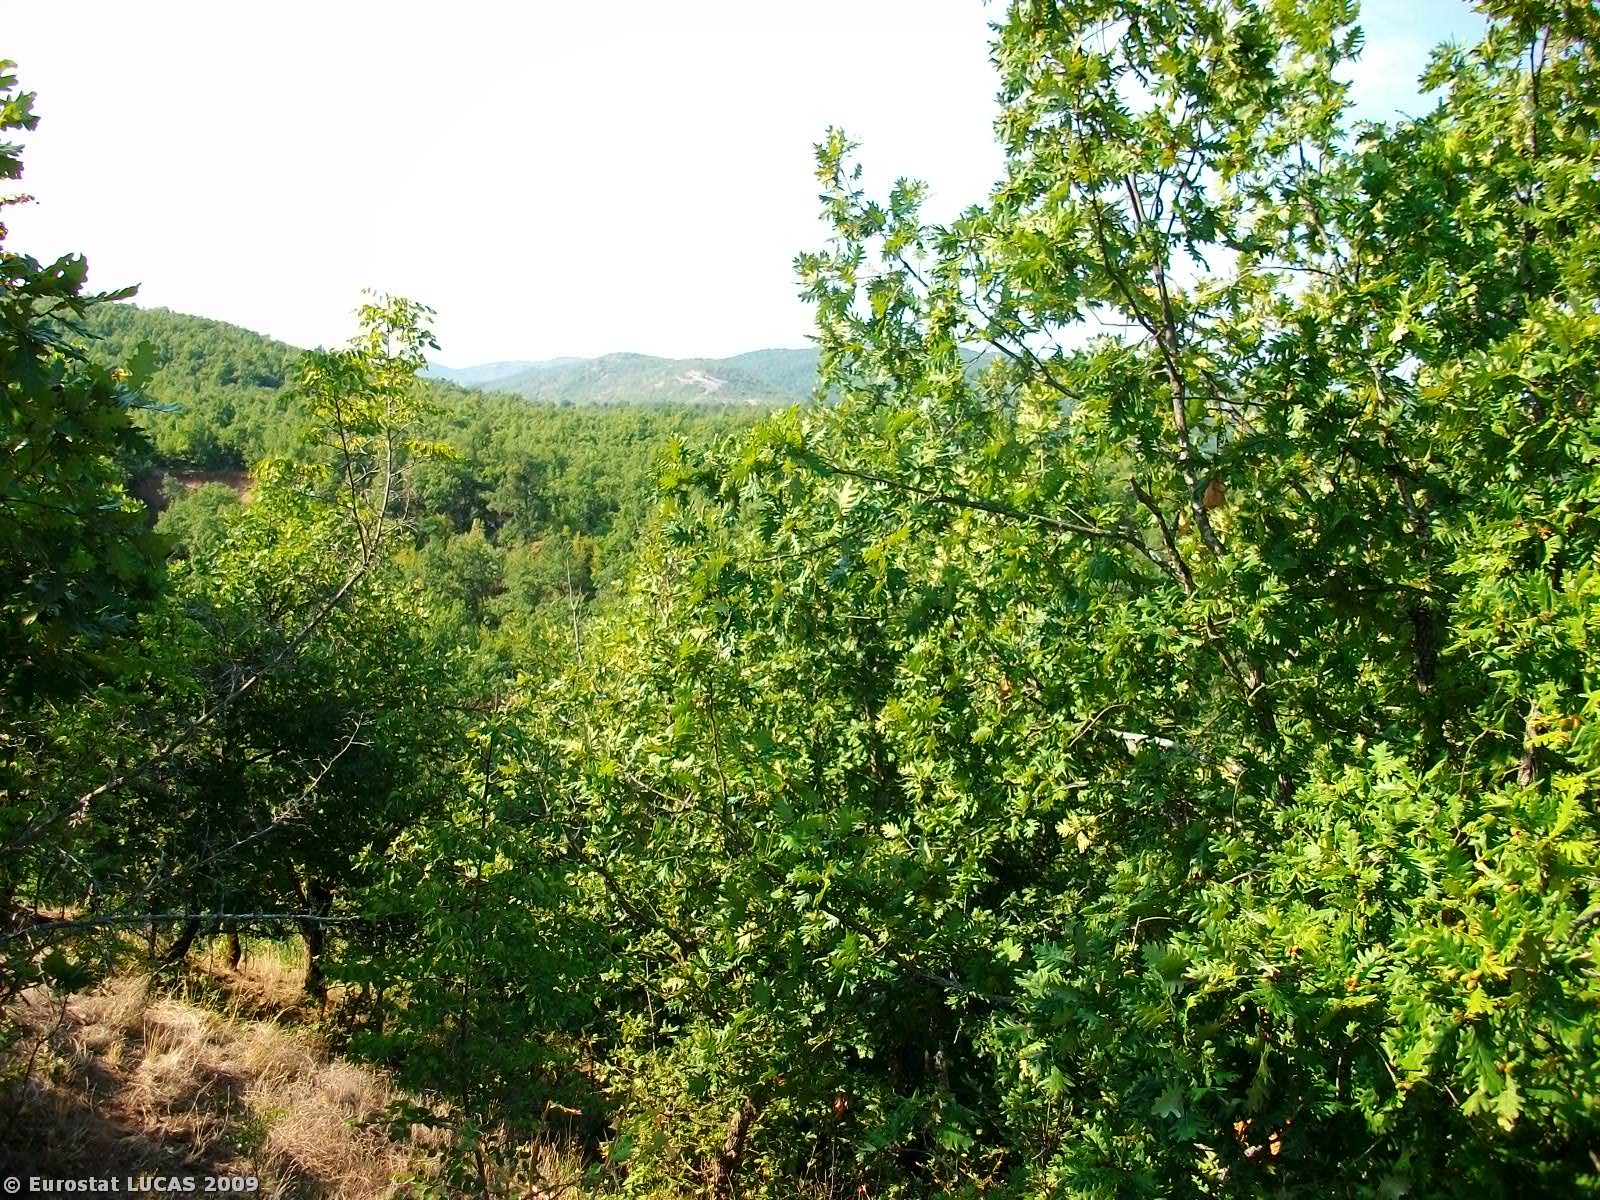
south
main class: Woodland
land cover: Broadleaved woodland
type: thermophilous deciduous forest
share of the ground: > 75 %
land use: Forestry
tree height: > 5 m
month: August
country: GR
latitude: 39.9093
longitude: 21.7199
